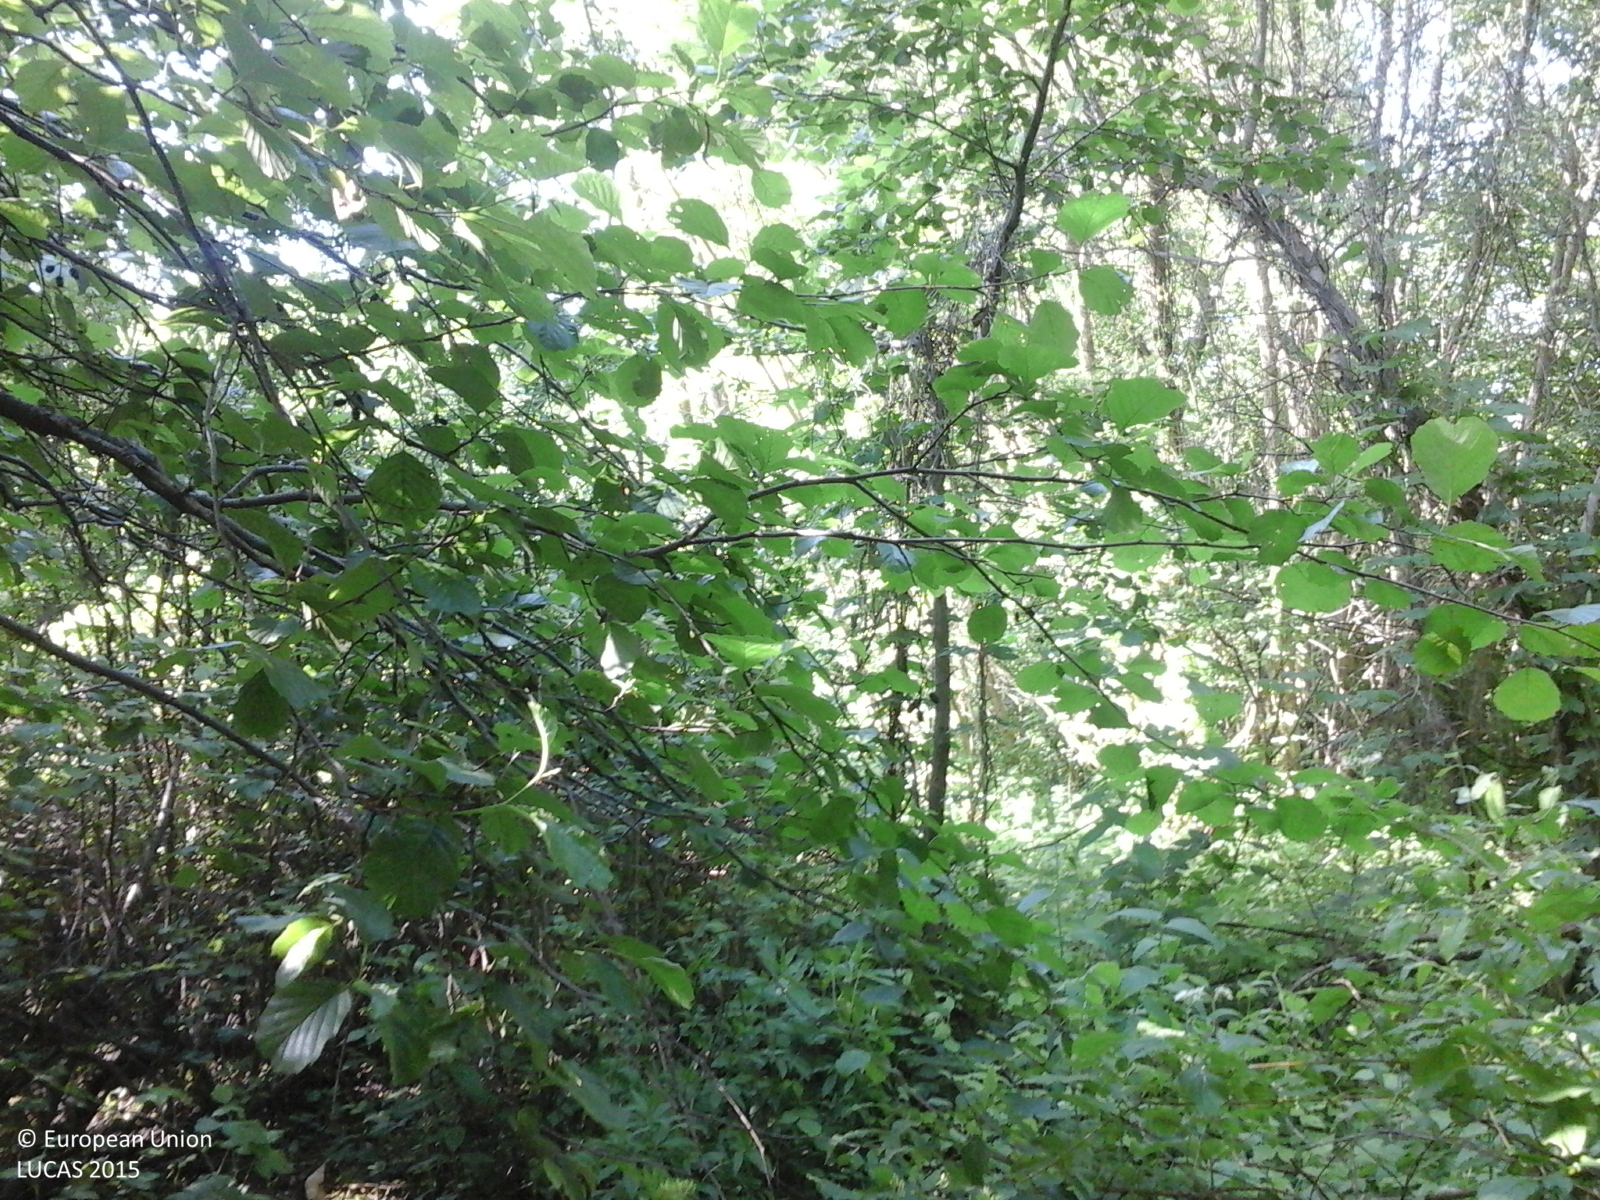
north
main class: Woodland
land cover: Broadleaved woodland
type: mesophytic deciduous forest
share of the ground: > 75 %
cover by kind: broadleaved forest trees 100 %
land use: Forestry
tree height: > 5 m
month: May
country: RO
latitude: 45.2026
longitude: 26.1678
